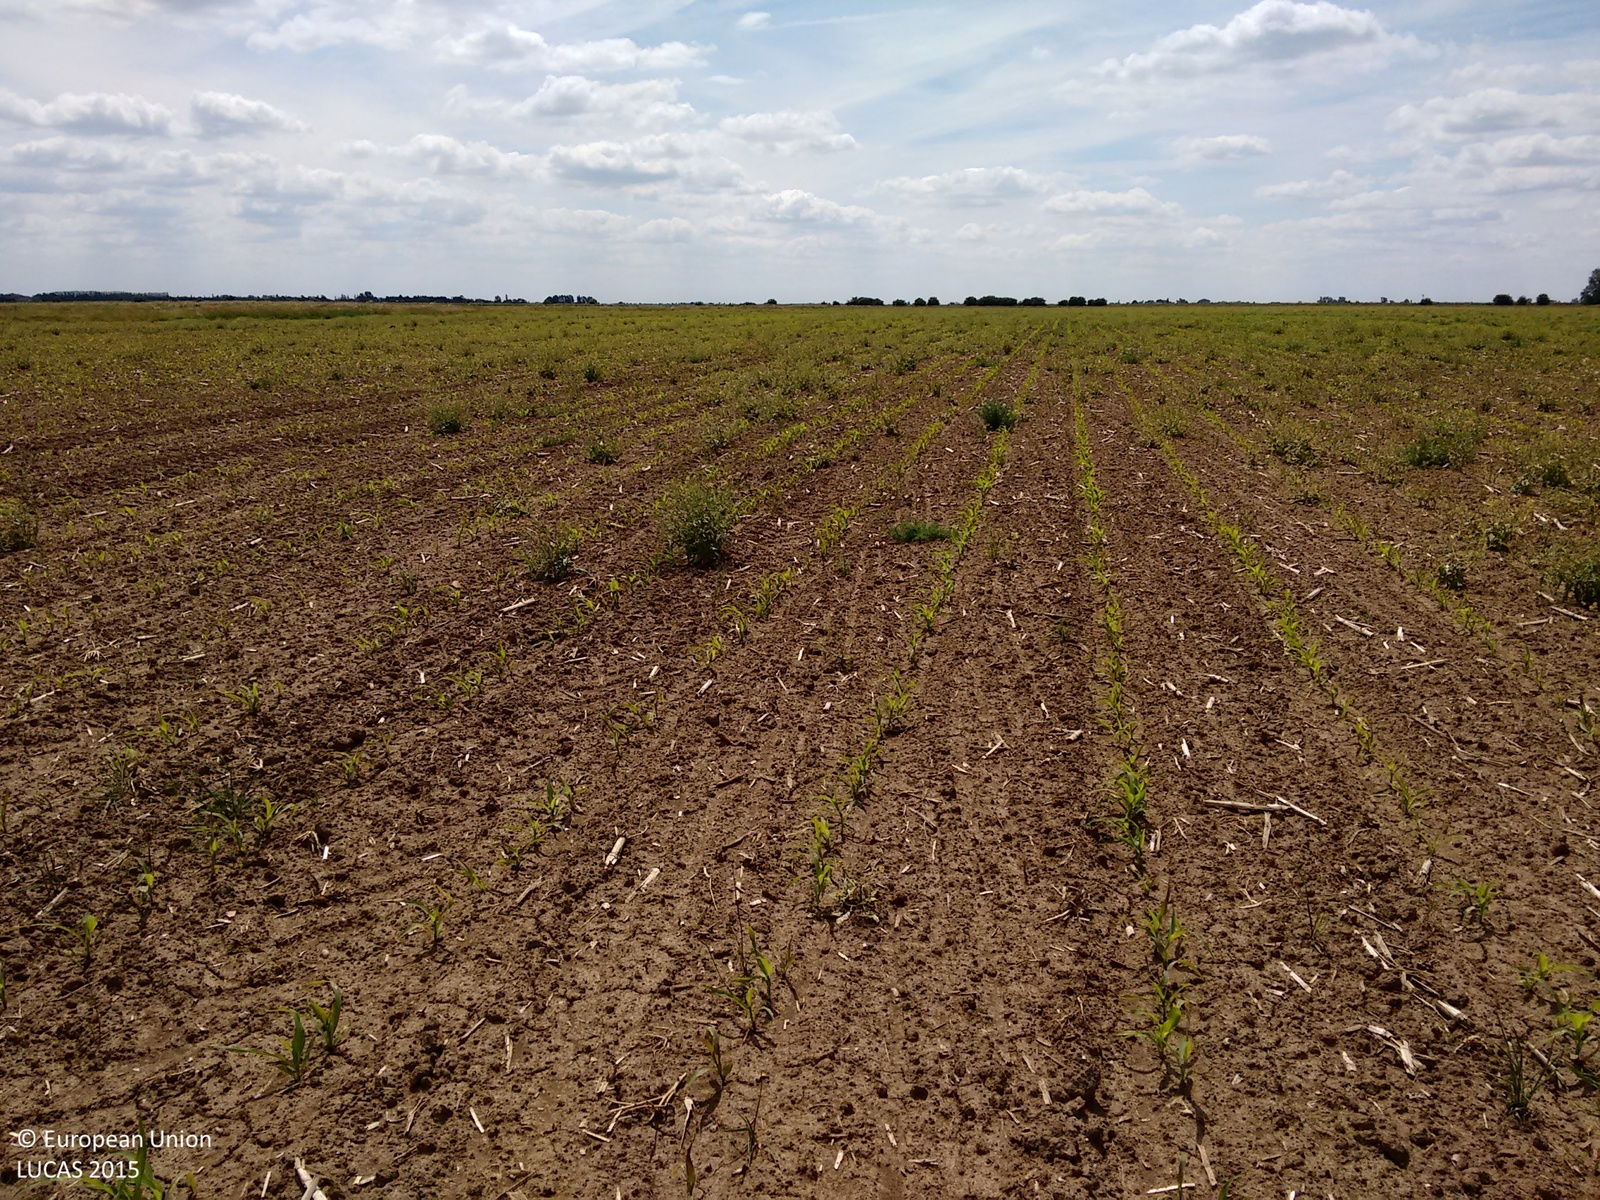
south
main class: Cropland
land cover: Maize
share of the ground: < 10 %
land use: Agriculture (excluding fallow land and kitchen gardens)
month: June
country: GB
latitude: 52.5120
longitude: 0.1706
